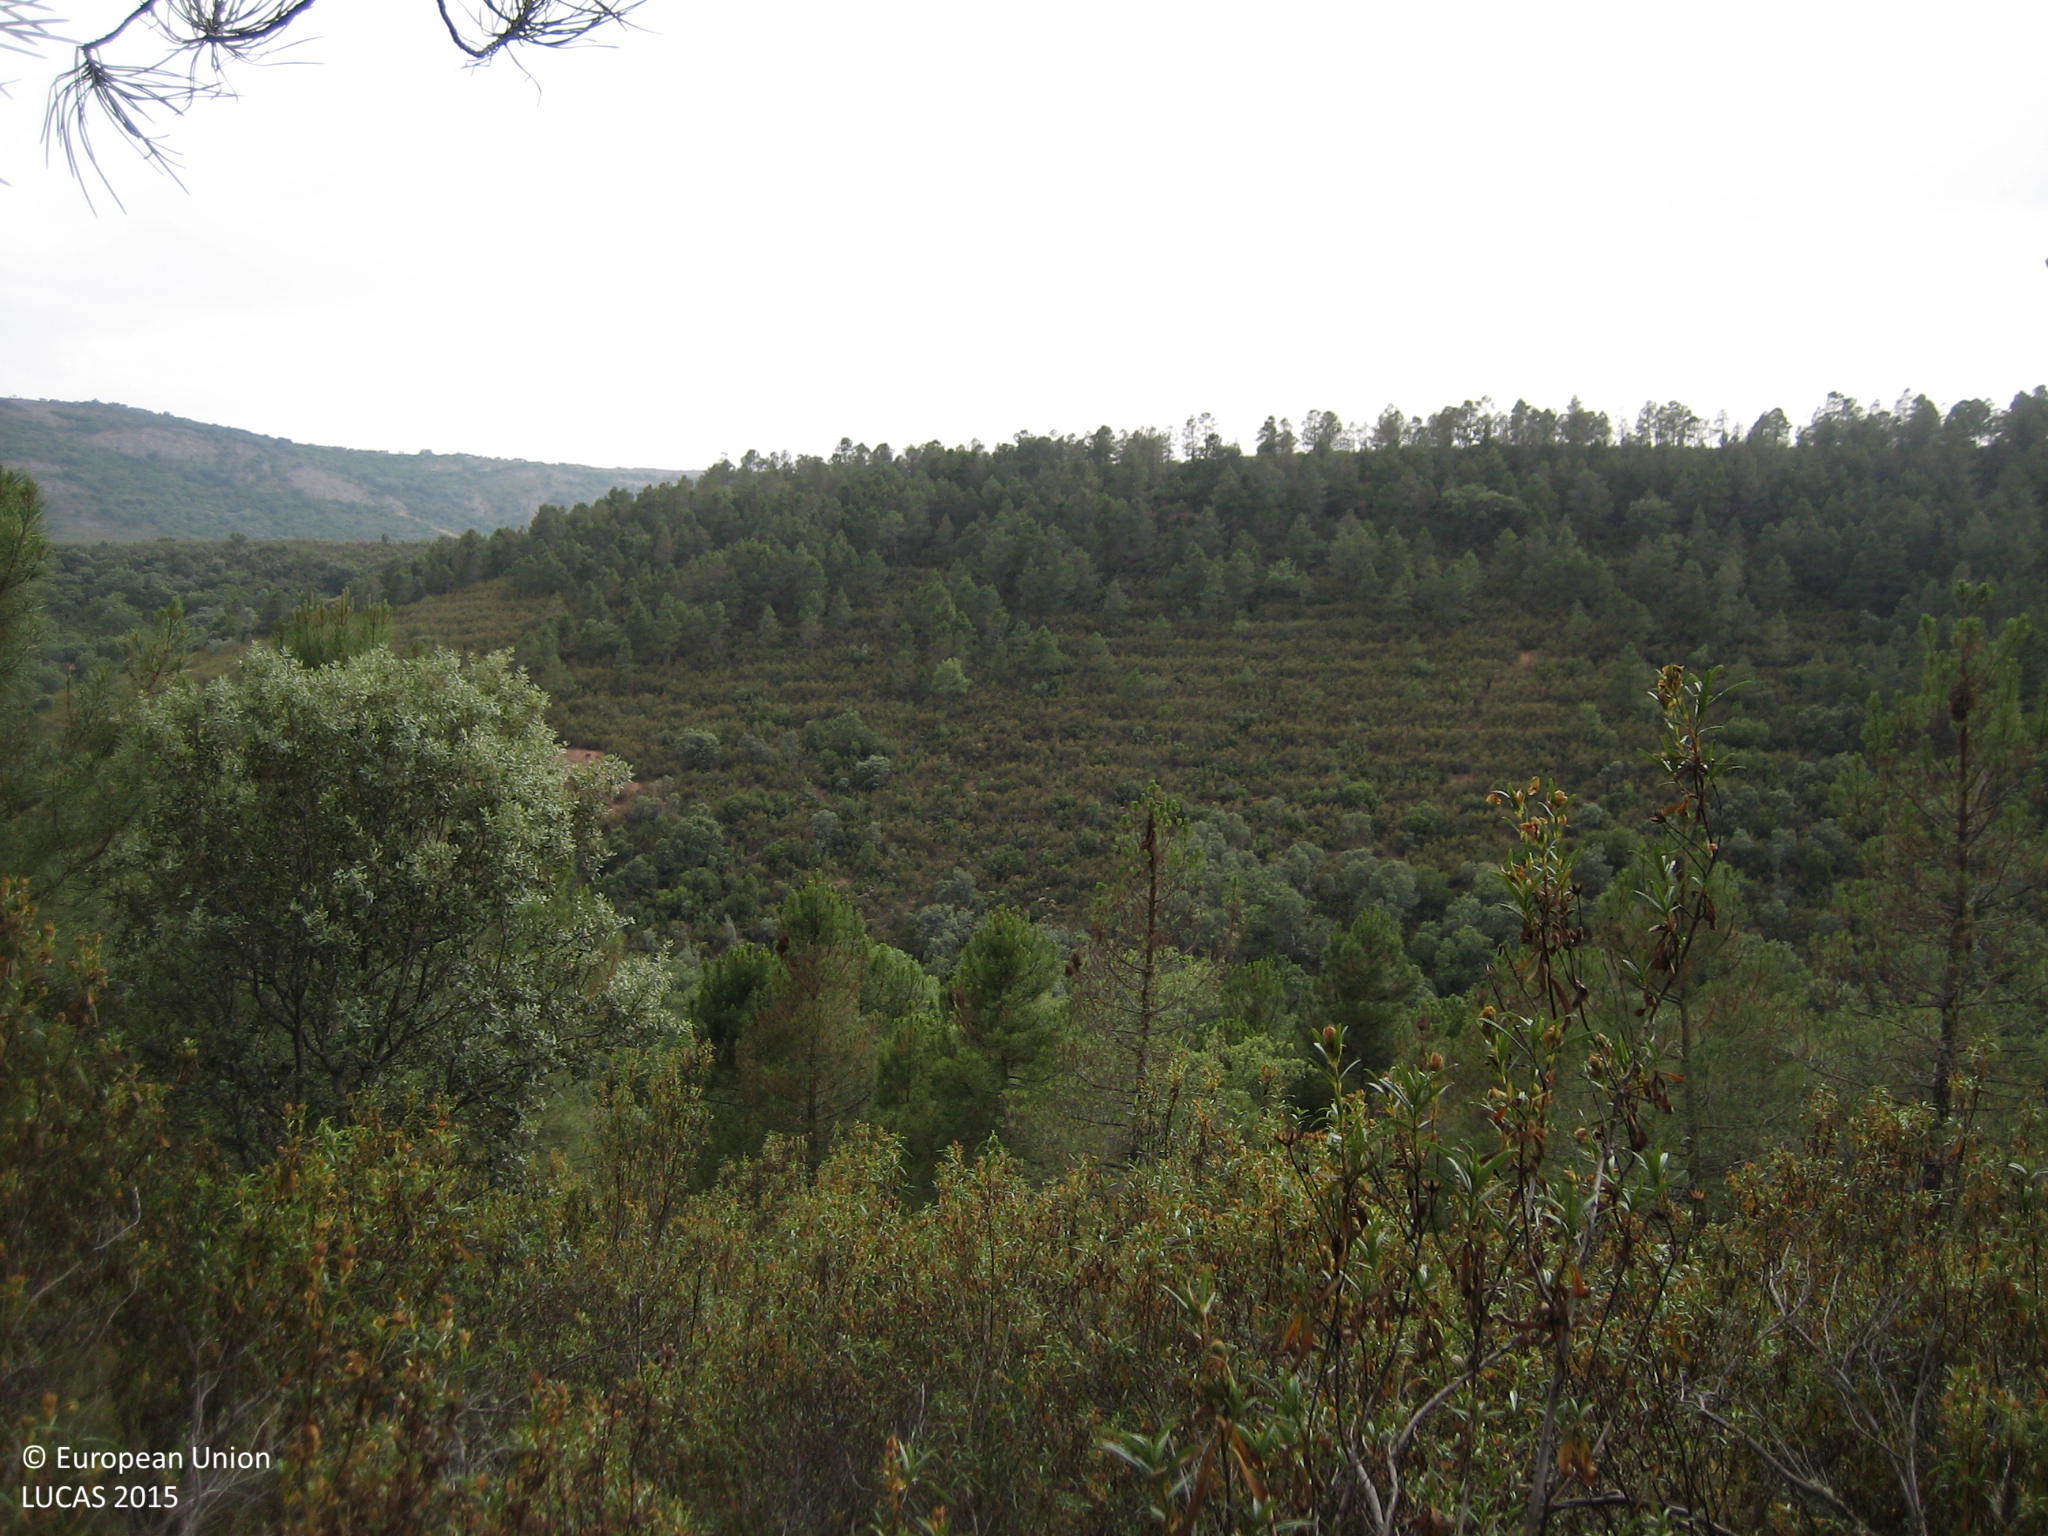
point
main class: Shrubland
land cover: Shrubland with sparse tree cover
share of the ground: > 75 %
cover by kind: shrubs 95 %, broadleaved forest trees 5 %
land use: Semi-natural and natural areas not in use
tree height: < 5 m
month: June
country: ES
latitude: 39.0575
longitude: -4.4856
